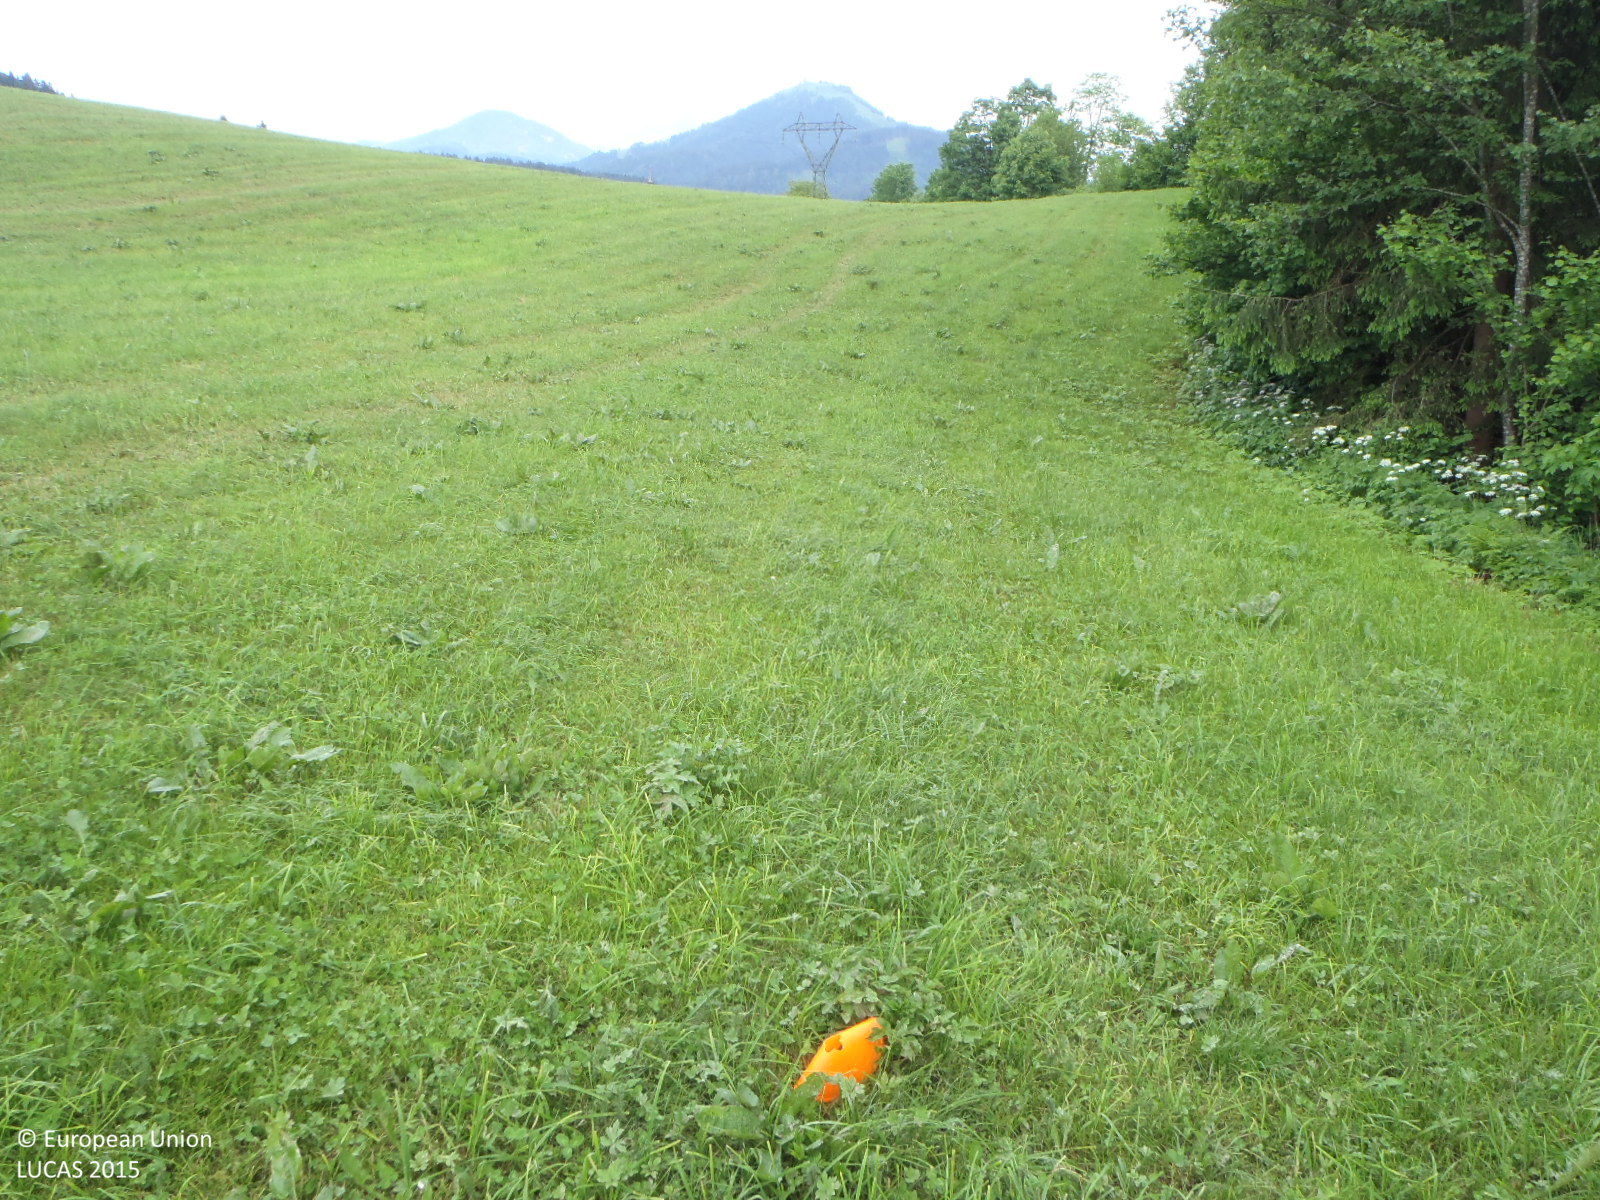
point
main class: Grassland
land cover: Grassland without tree/shrub cover
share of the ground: > 75 %
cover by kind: herbaceous plants 100 %
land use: Agriculture (excluding fallow land and kitchen gardens)
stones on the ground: < 10 %
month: June
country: AT
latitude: 47.4928
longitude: 12.5070
